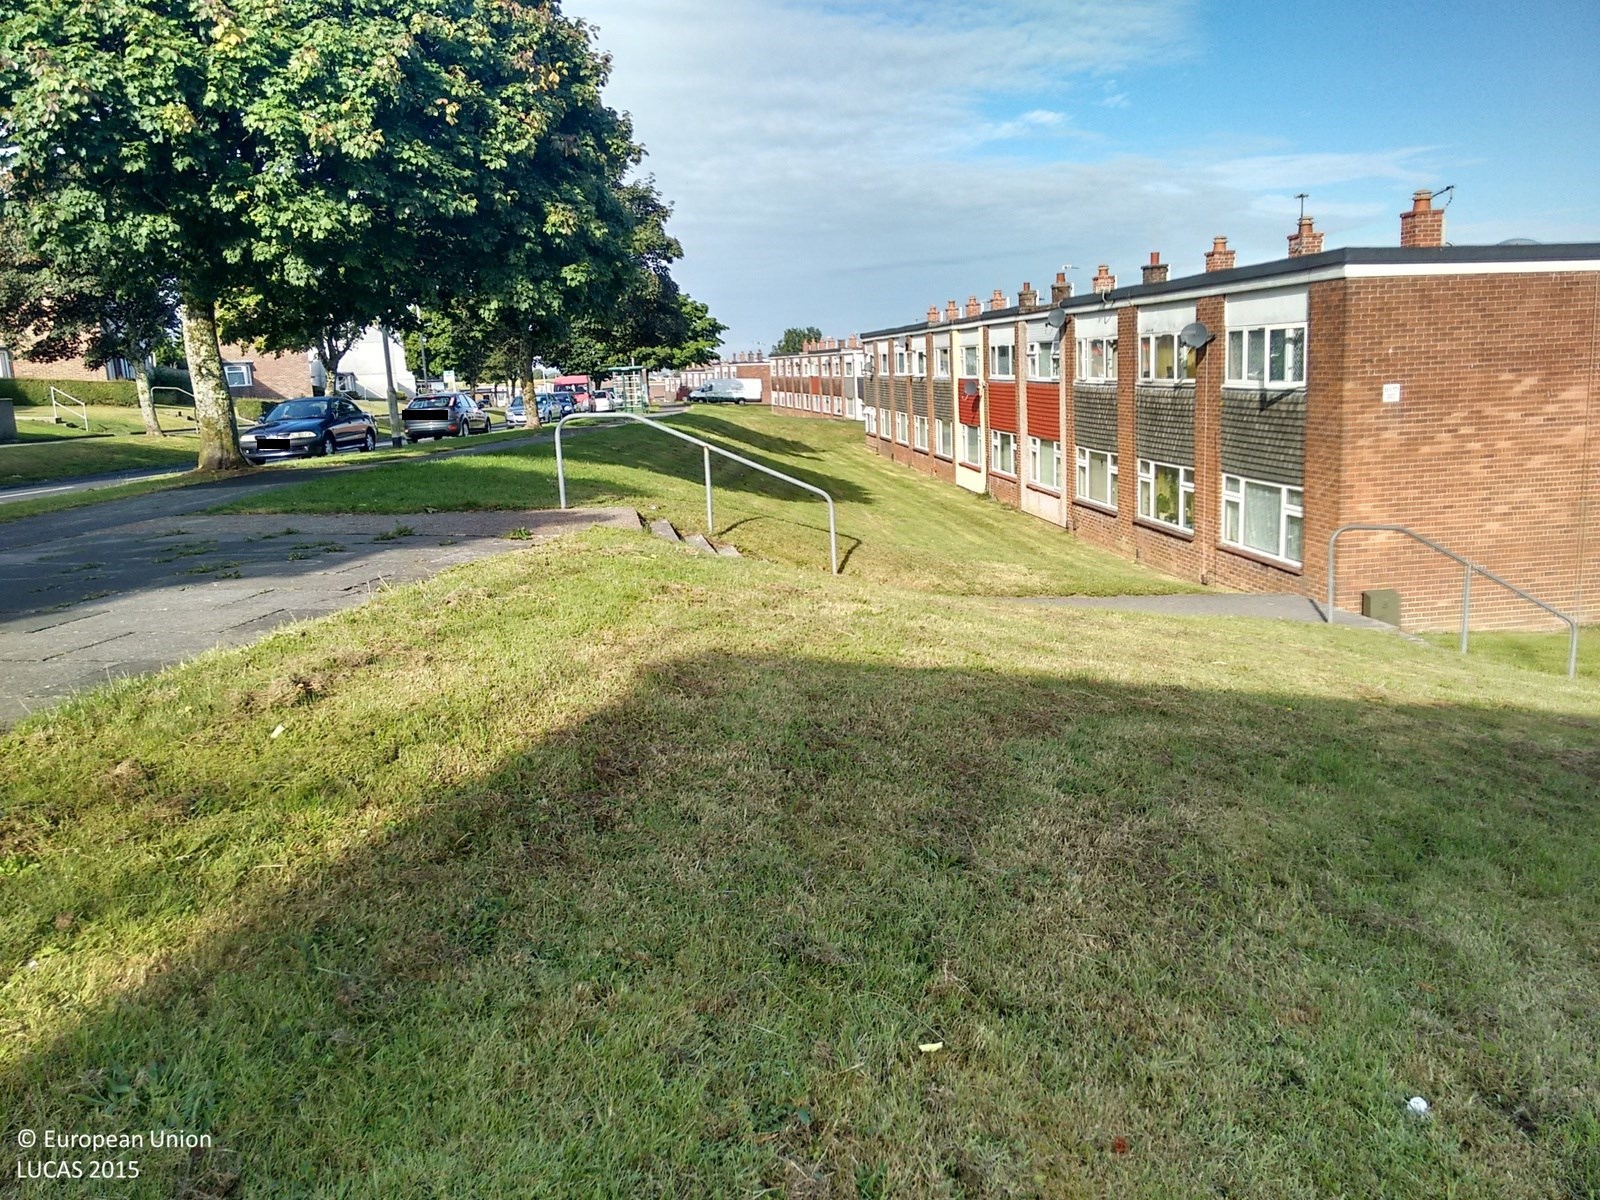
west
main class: Grassland
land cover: Grassland without tree/shrub cover
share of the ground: > 75 %
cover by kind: herbaceous plants 100 %
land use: Semi-natural and natural areas not in use
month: August
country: GB
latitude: 50.4305
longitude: -4.1317
